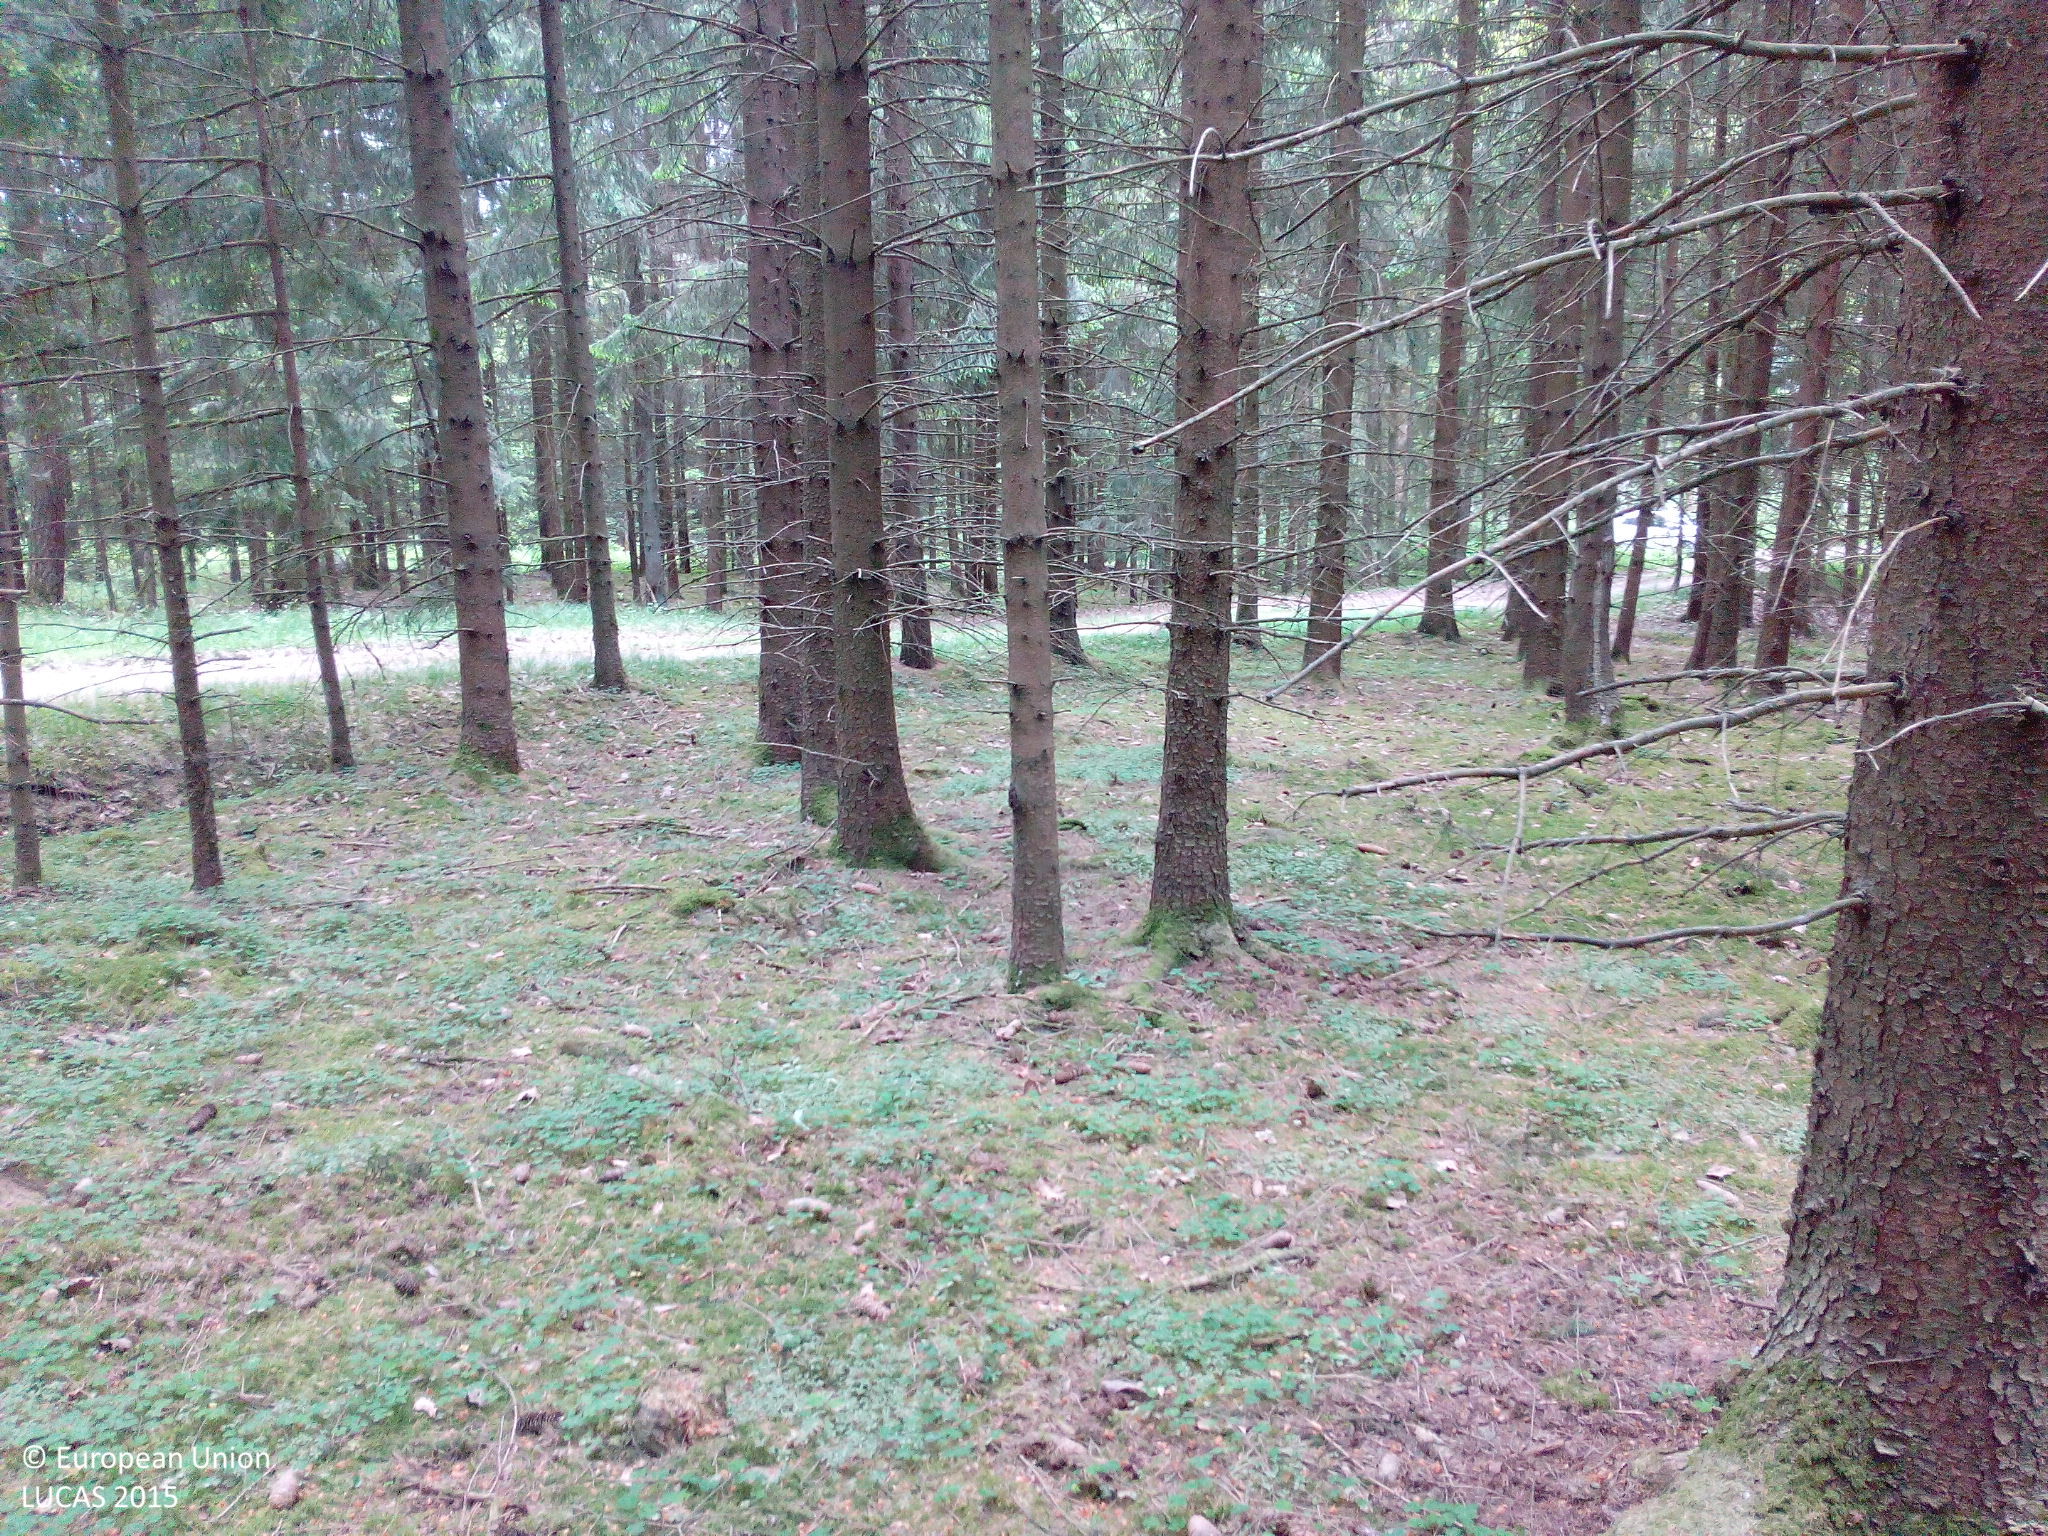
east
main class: Woodland
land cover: Spruce dominated coniferous woodland
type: hemiboreal forest and nemoral coniferous forest and mixed broadleaved-coniferous forest
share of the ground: > 75 %
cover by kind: coniferous forest trees 80 %, herbaceous plants 20 %
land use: Forestry
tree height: > 5 m
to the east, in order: Spruce dominated coniferous woodland; Ditches and canals; Grass margins; Tracks; Grass margins; Spruce dominated coniferous woodland; Ditches and canals; Grass margins; Tracks; Spruce dominated coniferous woodland; Grass margins; Ditches and canals; Grass margins; Fences; Broadleaved woodland; Grassland without tree/shrub cover; Paved roads, cycling and walking lanes; Grassland without tree/shrub cover; Broadleaved woodland; Fences; Ditches and canals; Spruce dominated mixed woodland; Fences; Other mixed woodland
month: May
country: DE
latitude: 49.1408
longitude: 10.2603
